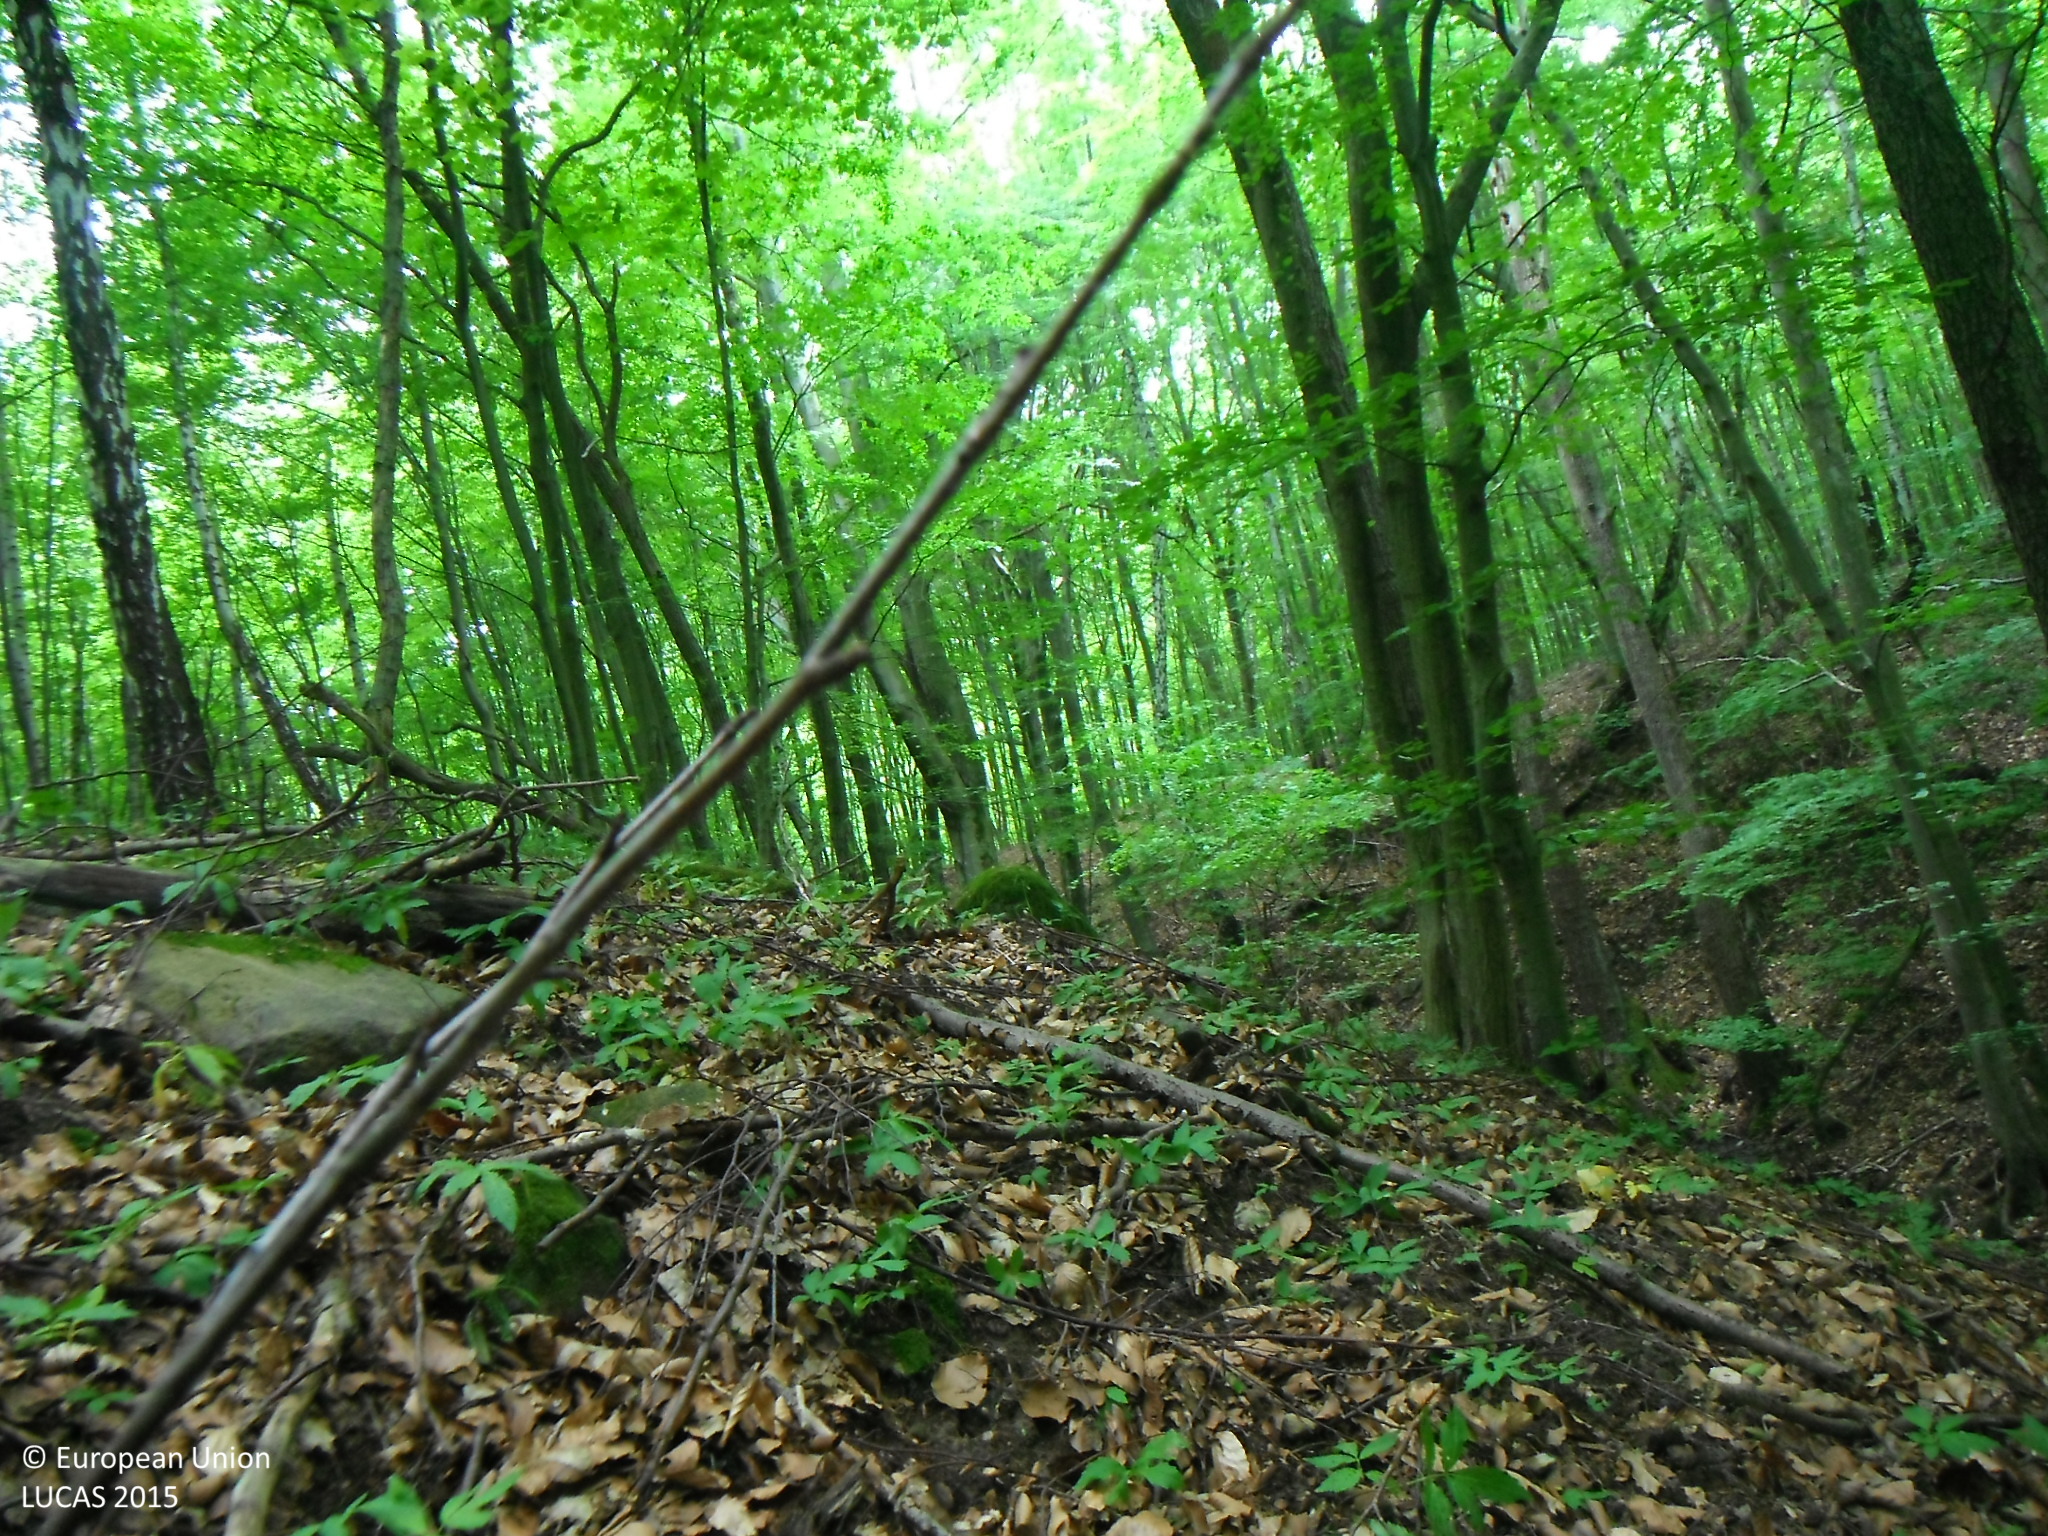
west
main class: Woodland
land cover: Broadleaved woodland
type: beech forest
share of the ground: > 75 %
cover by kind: broadleaved forest trees 100 %
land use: Forestry
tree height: > 5 m
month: June
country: SK
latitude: 48.8691
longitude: 21.5414
